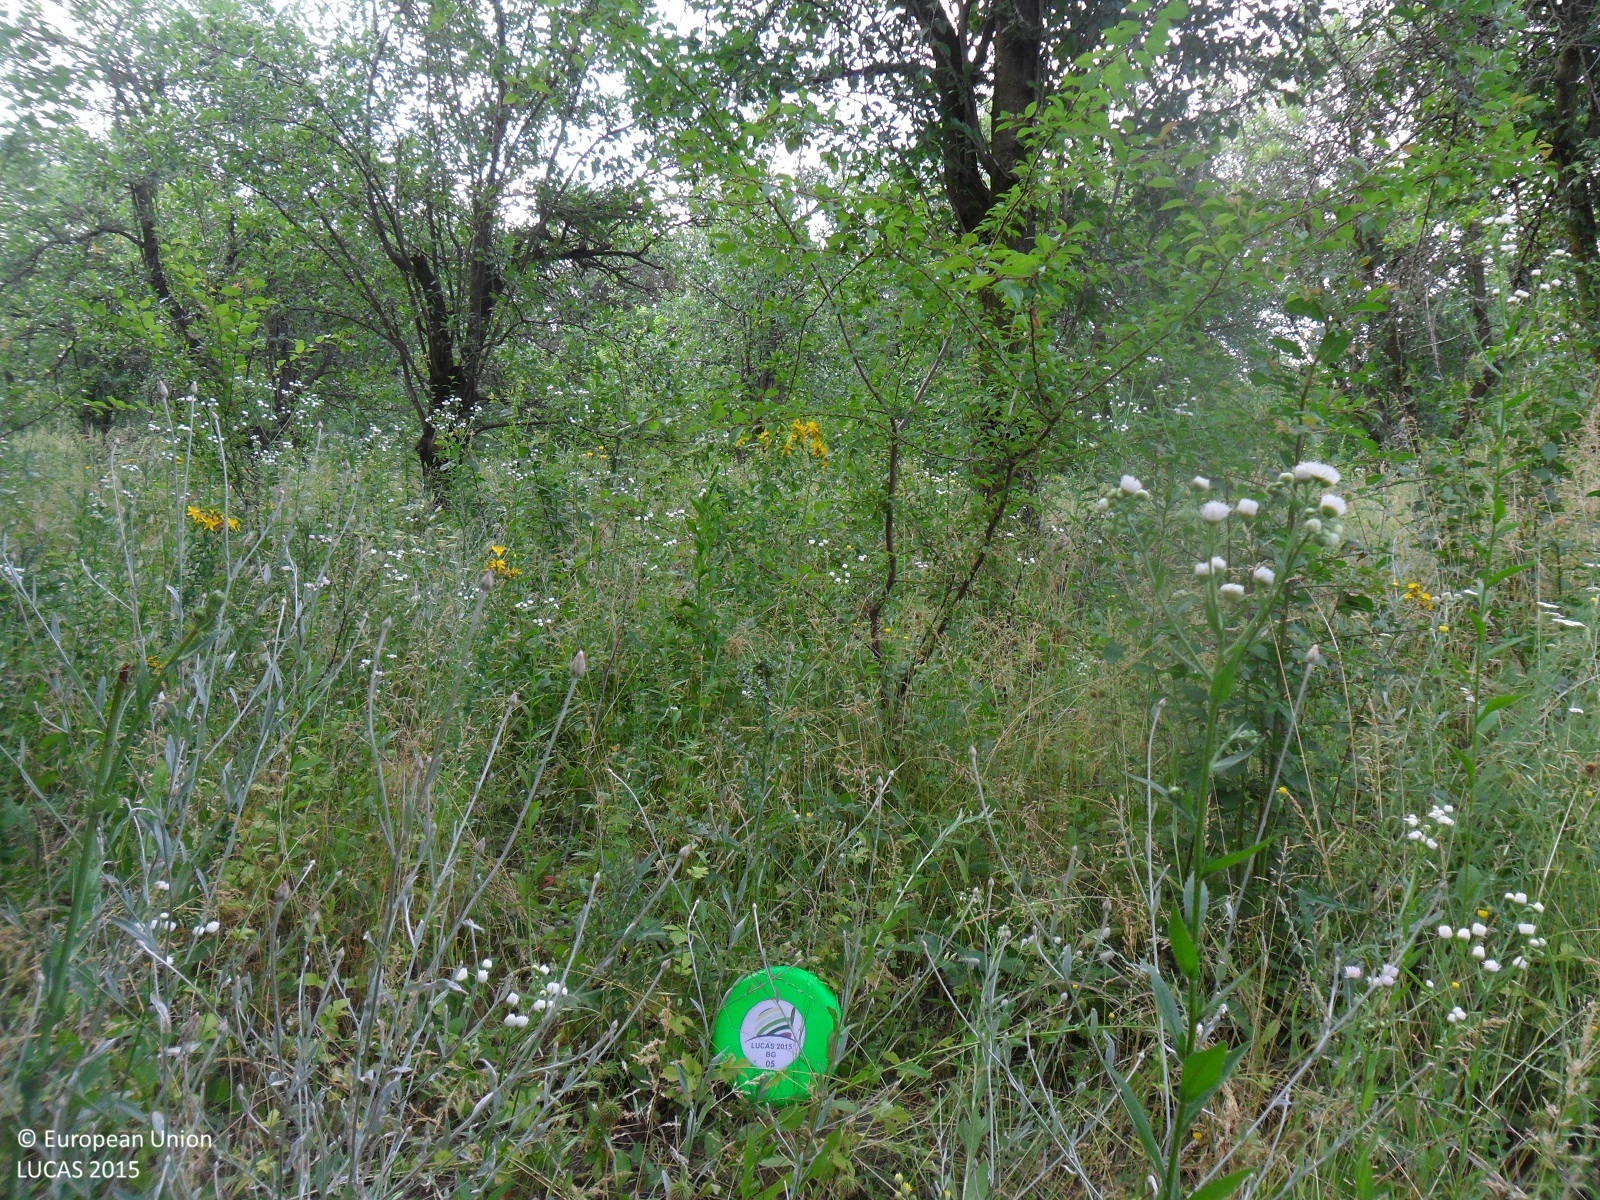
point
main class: Cropland
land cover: Other fruit trees and berries
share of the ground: 50 - 75 %
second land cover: Spontaneously vegetated surfaces
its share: > 75 %
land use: Agriculture (excluding fallow land and kitchen gardens)
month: June
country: BG
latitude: 43.7564
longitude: 26.8209
